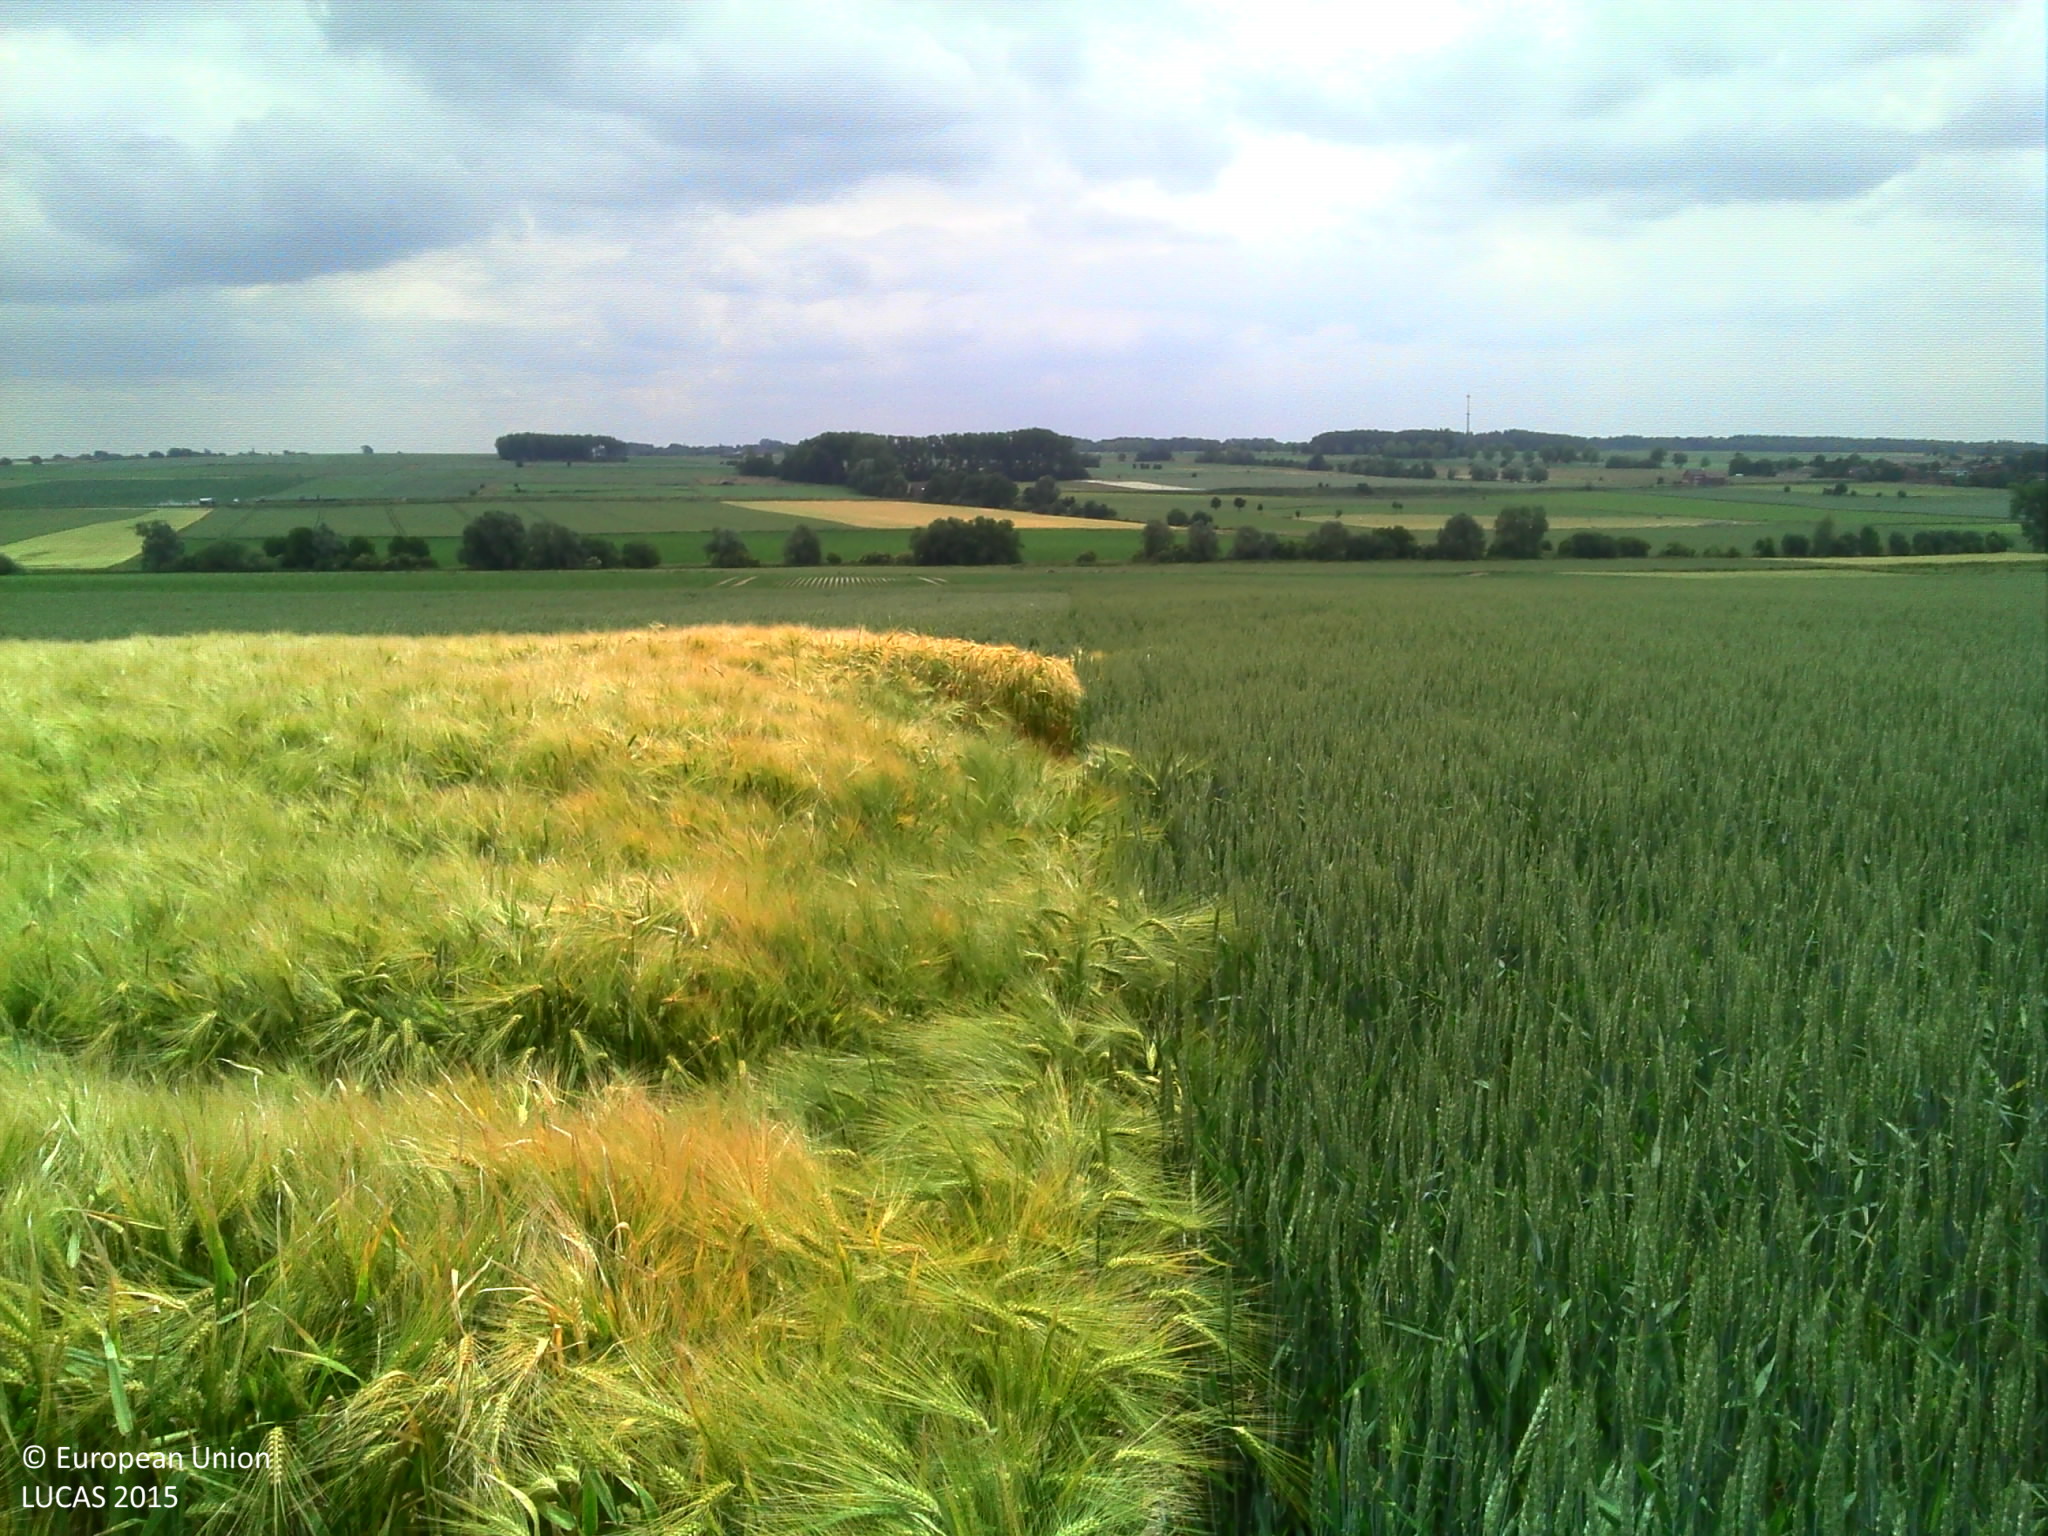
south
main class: Cropland
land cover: Barley
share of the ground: > 75 %
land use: Agriculture (excluding fallow land and kitchen gardens)
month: June
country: BE
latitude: 50.3892
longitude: 4.0448
